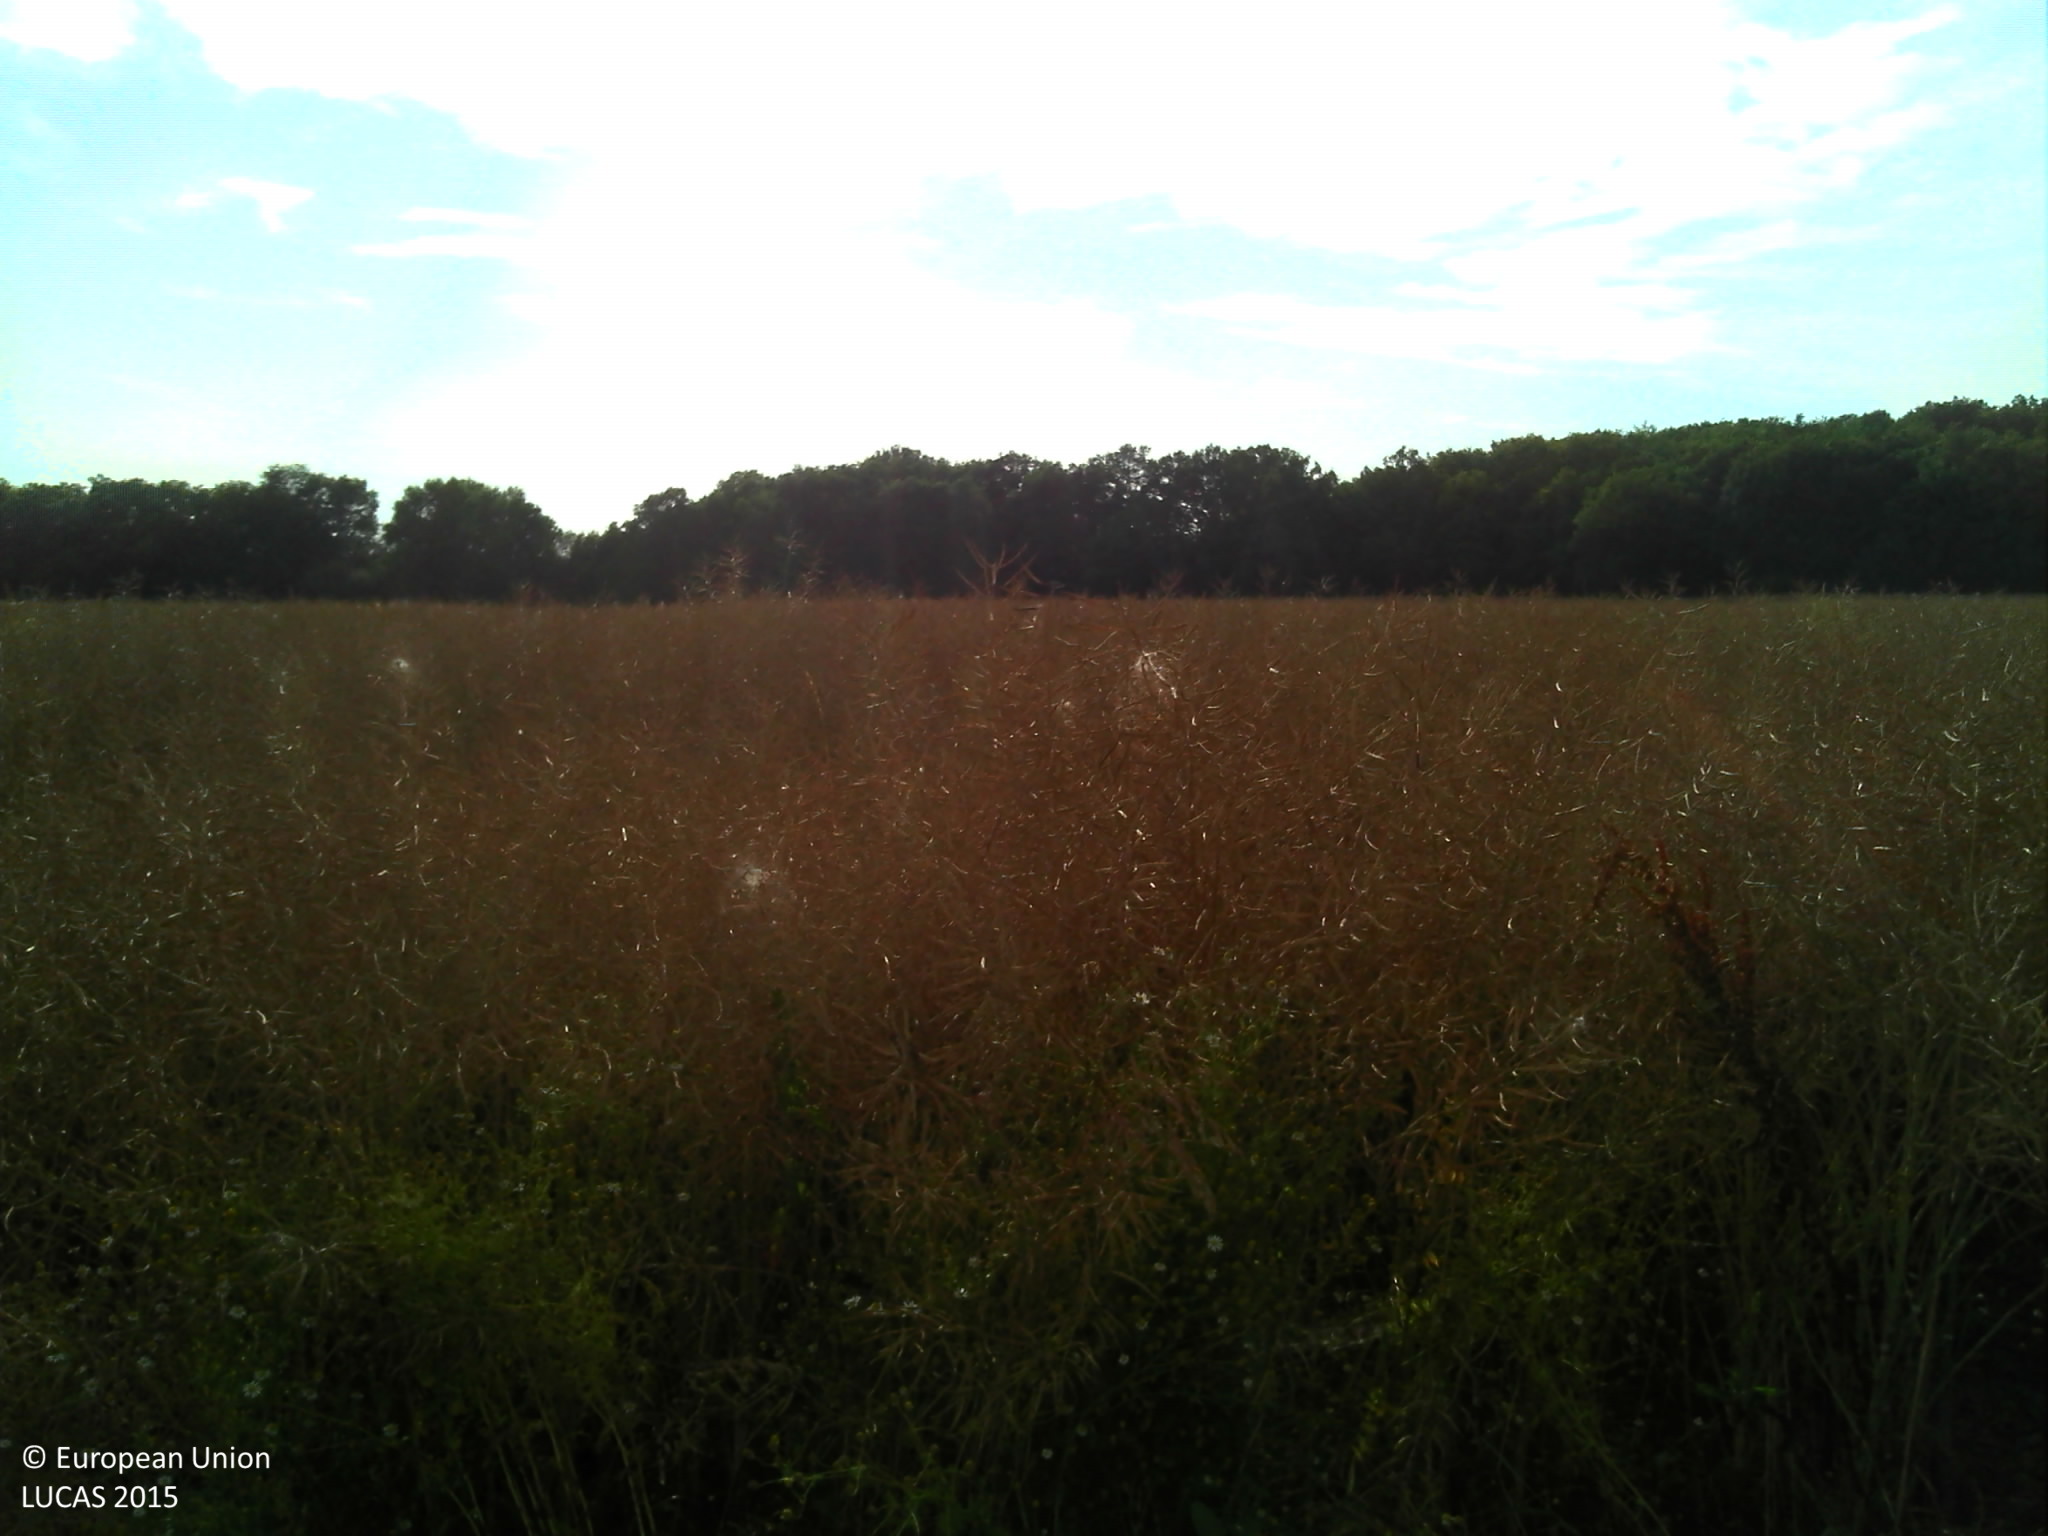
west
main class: Cropland
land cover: Rape and turnip rape
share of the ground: > 75 %
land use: Agriculture (excluding fallow land and kitchen gardens)
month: July
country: FR
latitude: 47.1514
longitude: 3.5746
